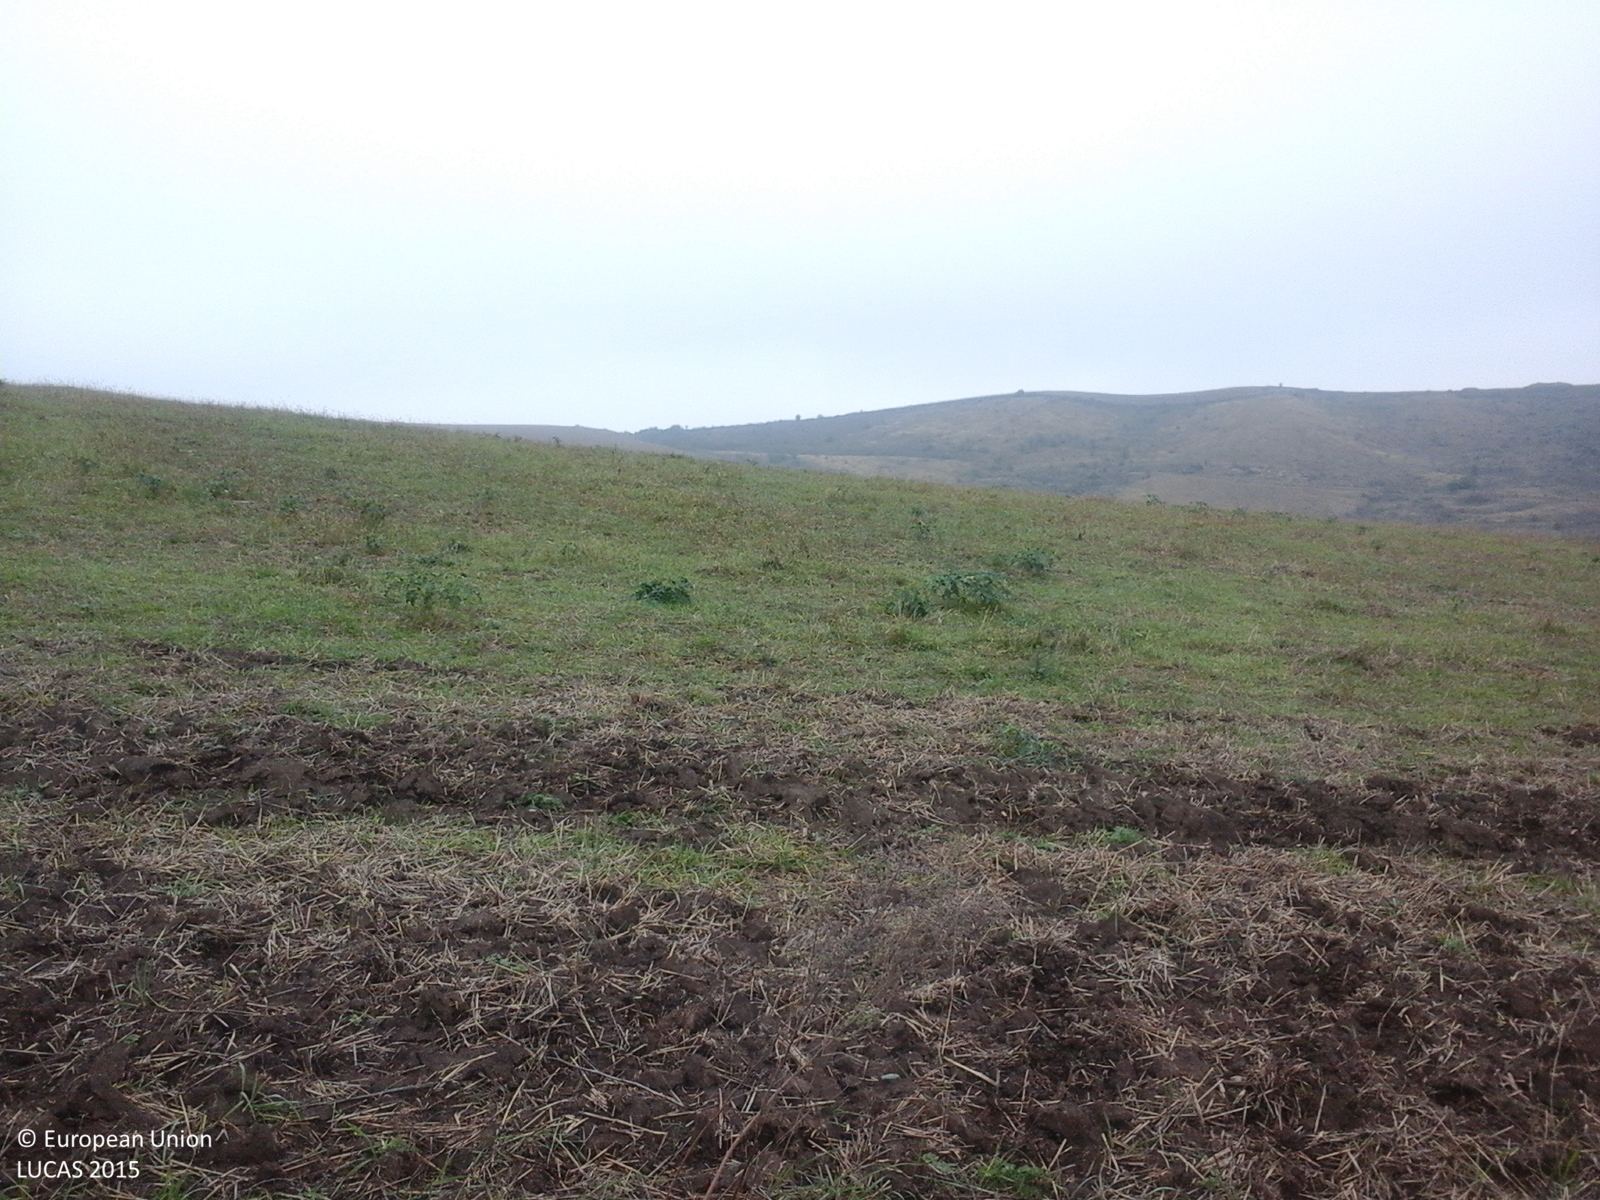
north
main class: Grassland
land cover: Grassland with sparse tree/shrub cover
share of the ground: > 75 %
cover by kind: herbaceous plants 95 %, broadleaved forest trees 5 %
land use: Agriculture (excluding fallow land and kitchen gardens)
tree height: < 5 m
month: October
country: RO
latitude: 46.5941
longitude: 24.1380
